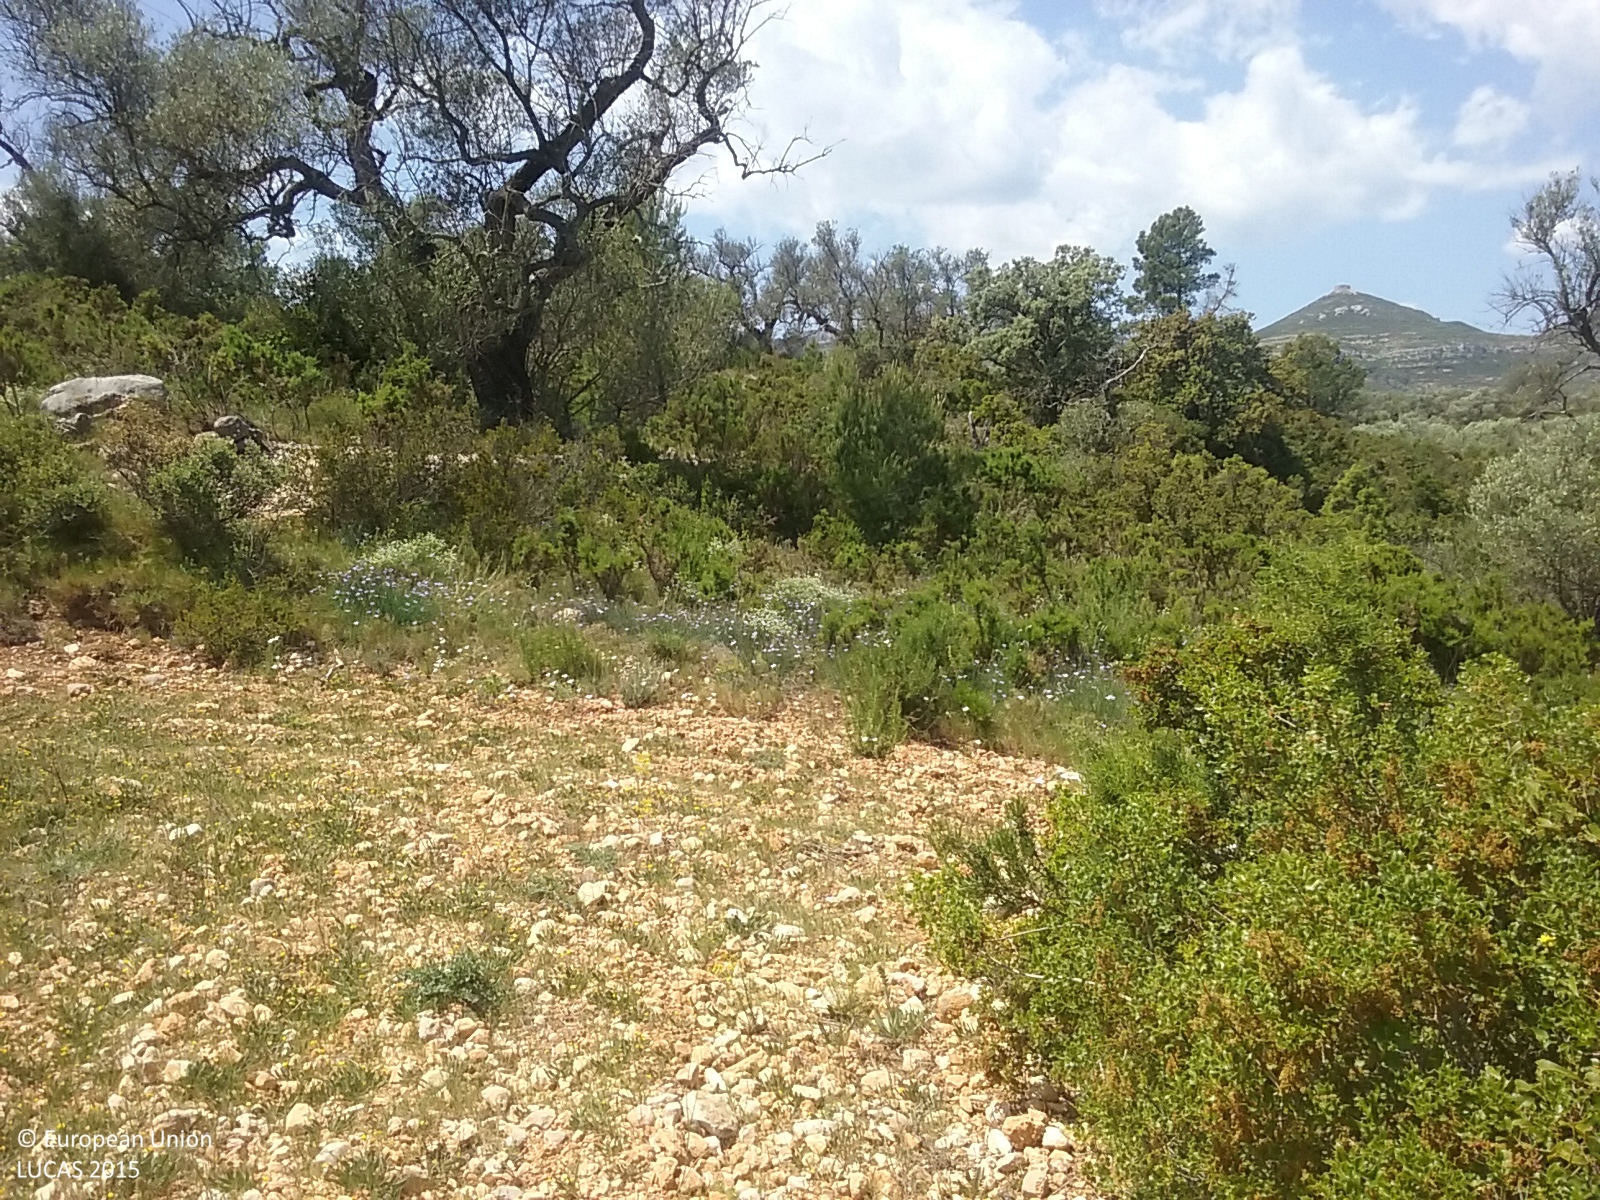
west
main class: Cropland
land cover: Olive groves
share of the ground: 10 - 25 %
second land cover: Other bare soil
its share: > 75 %
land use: Agriculture (excluding fallow land and kitchen gardens)
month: May
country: ES
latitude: 40.5411
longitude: 0.2069
